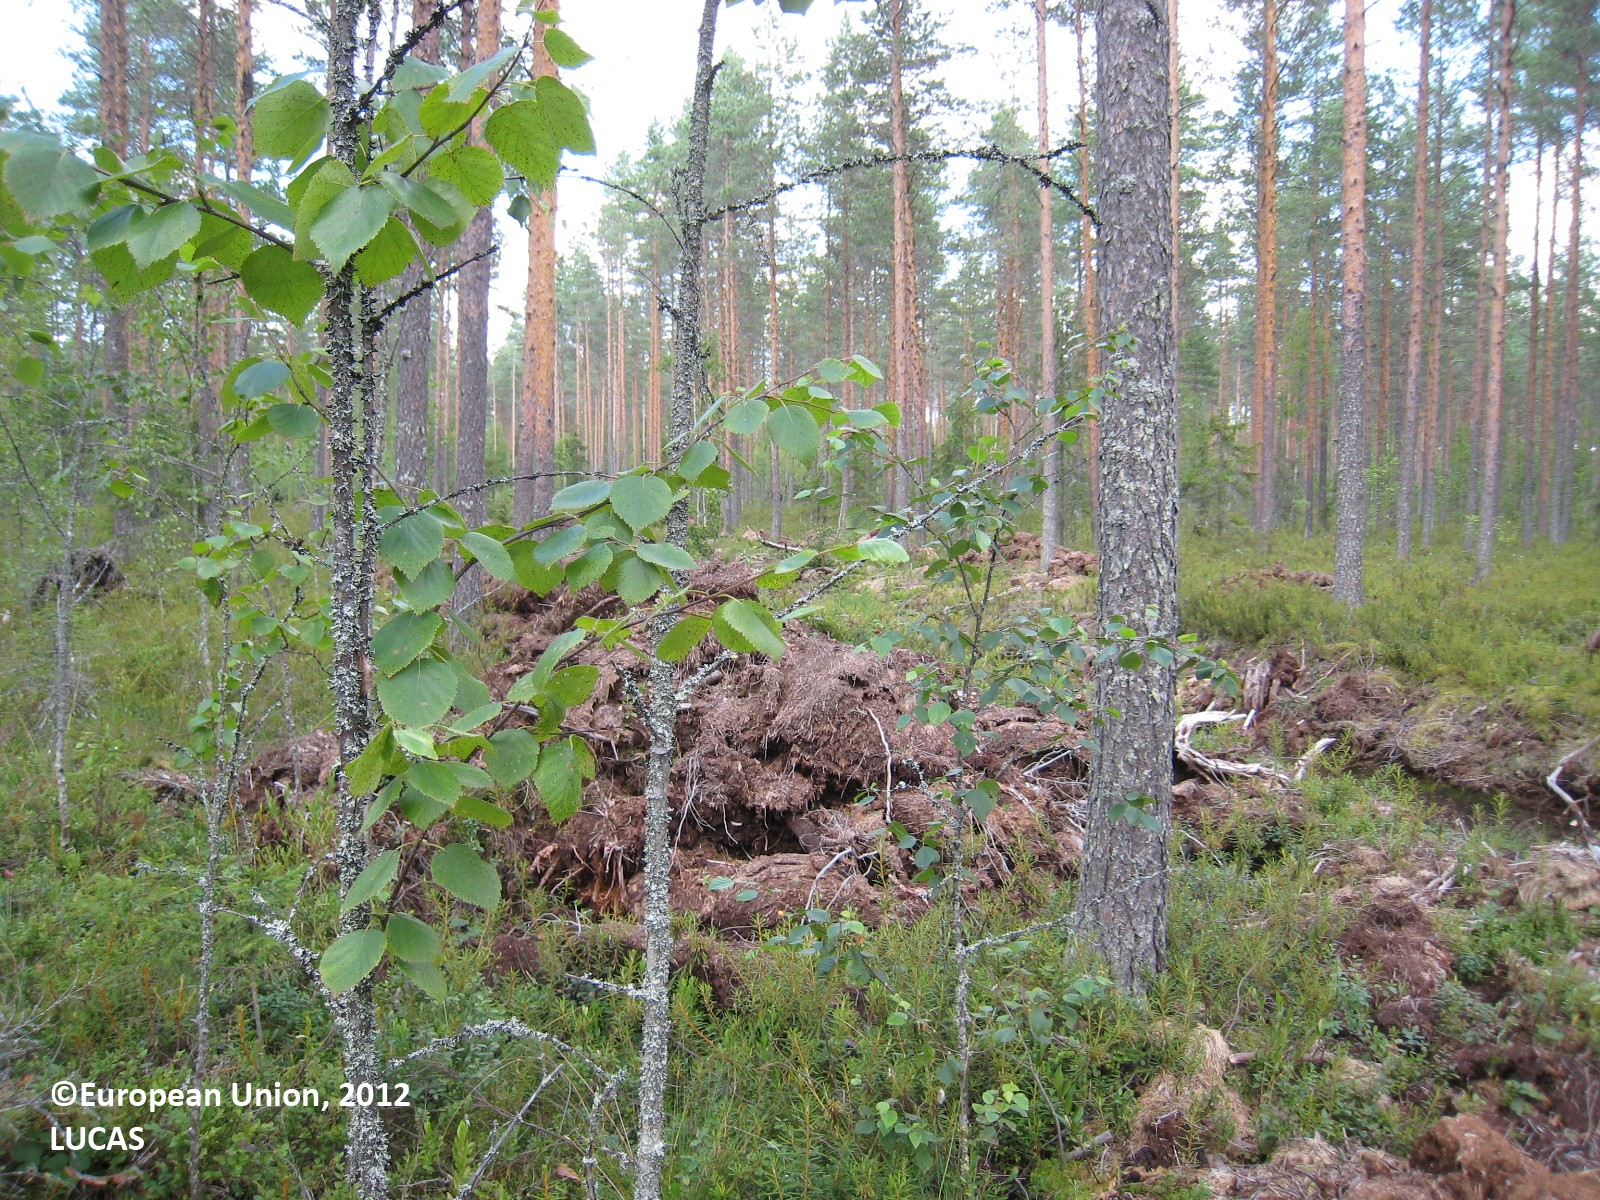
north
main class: Woodland
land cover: Pine dominated coniferous woodland
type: mire and swamp forests
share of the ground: 25 - 50 %
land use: Forestry
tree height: > 5 m
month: July
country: FI
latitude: 62.6546
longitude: 27.3121
